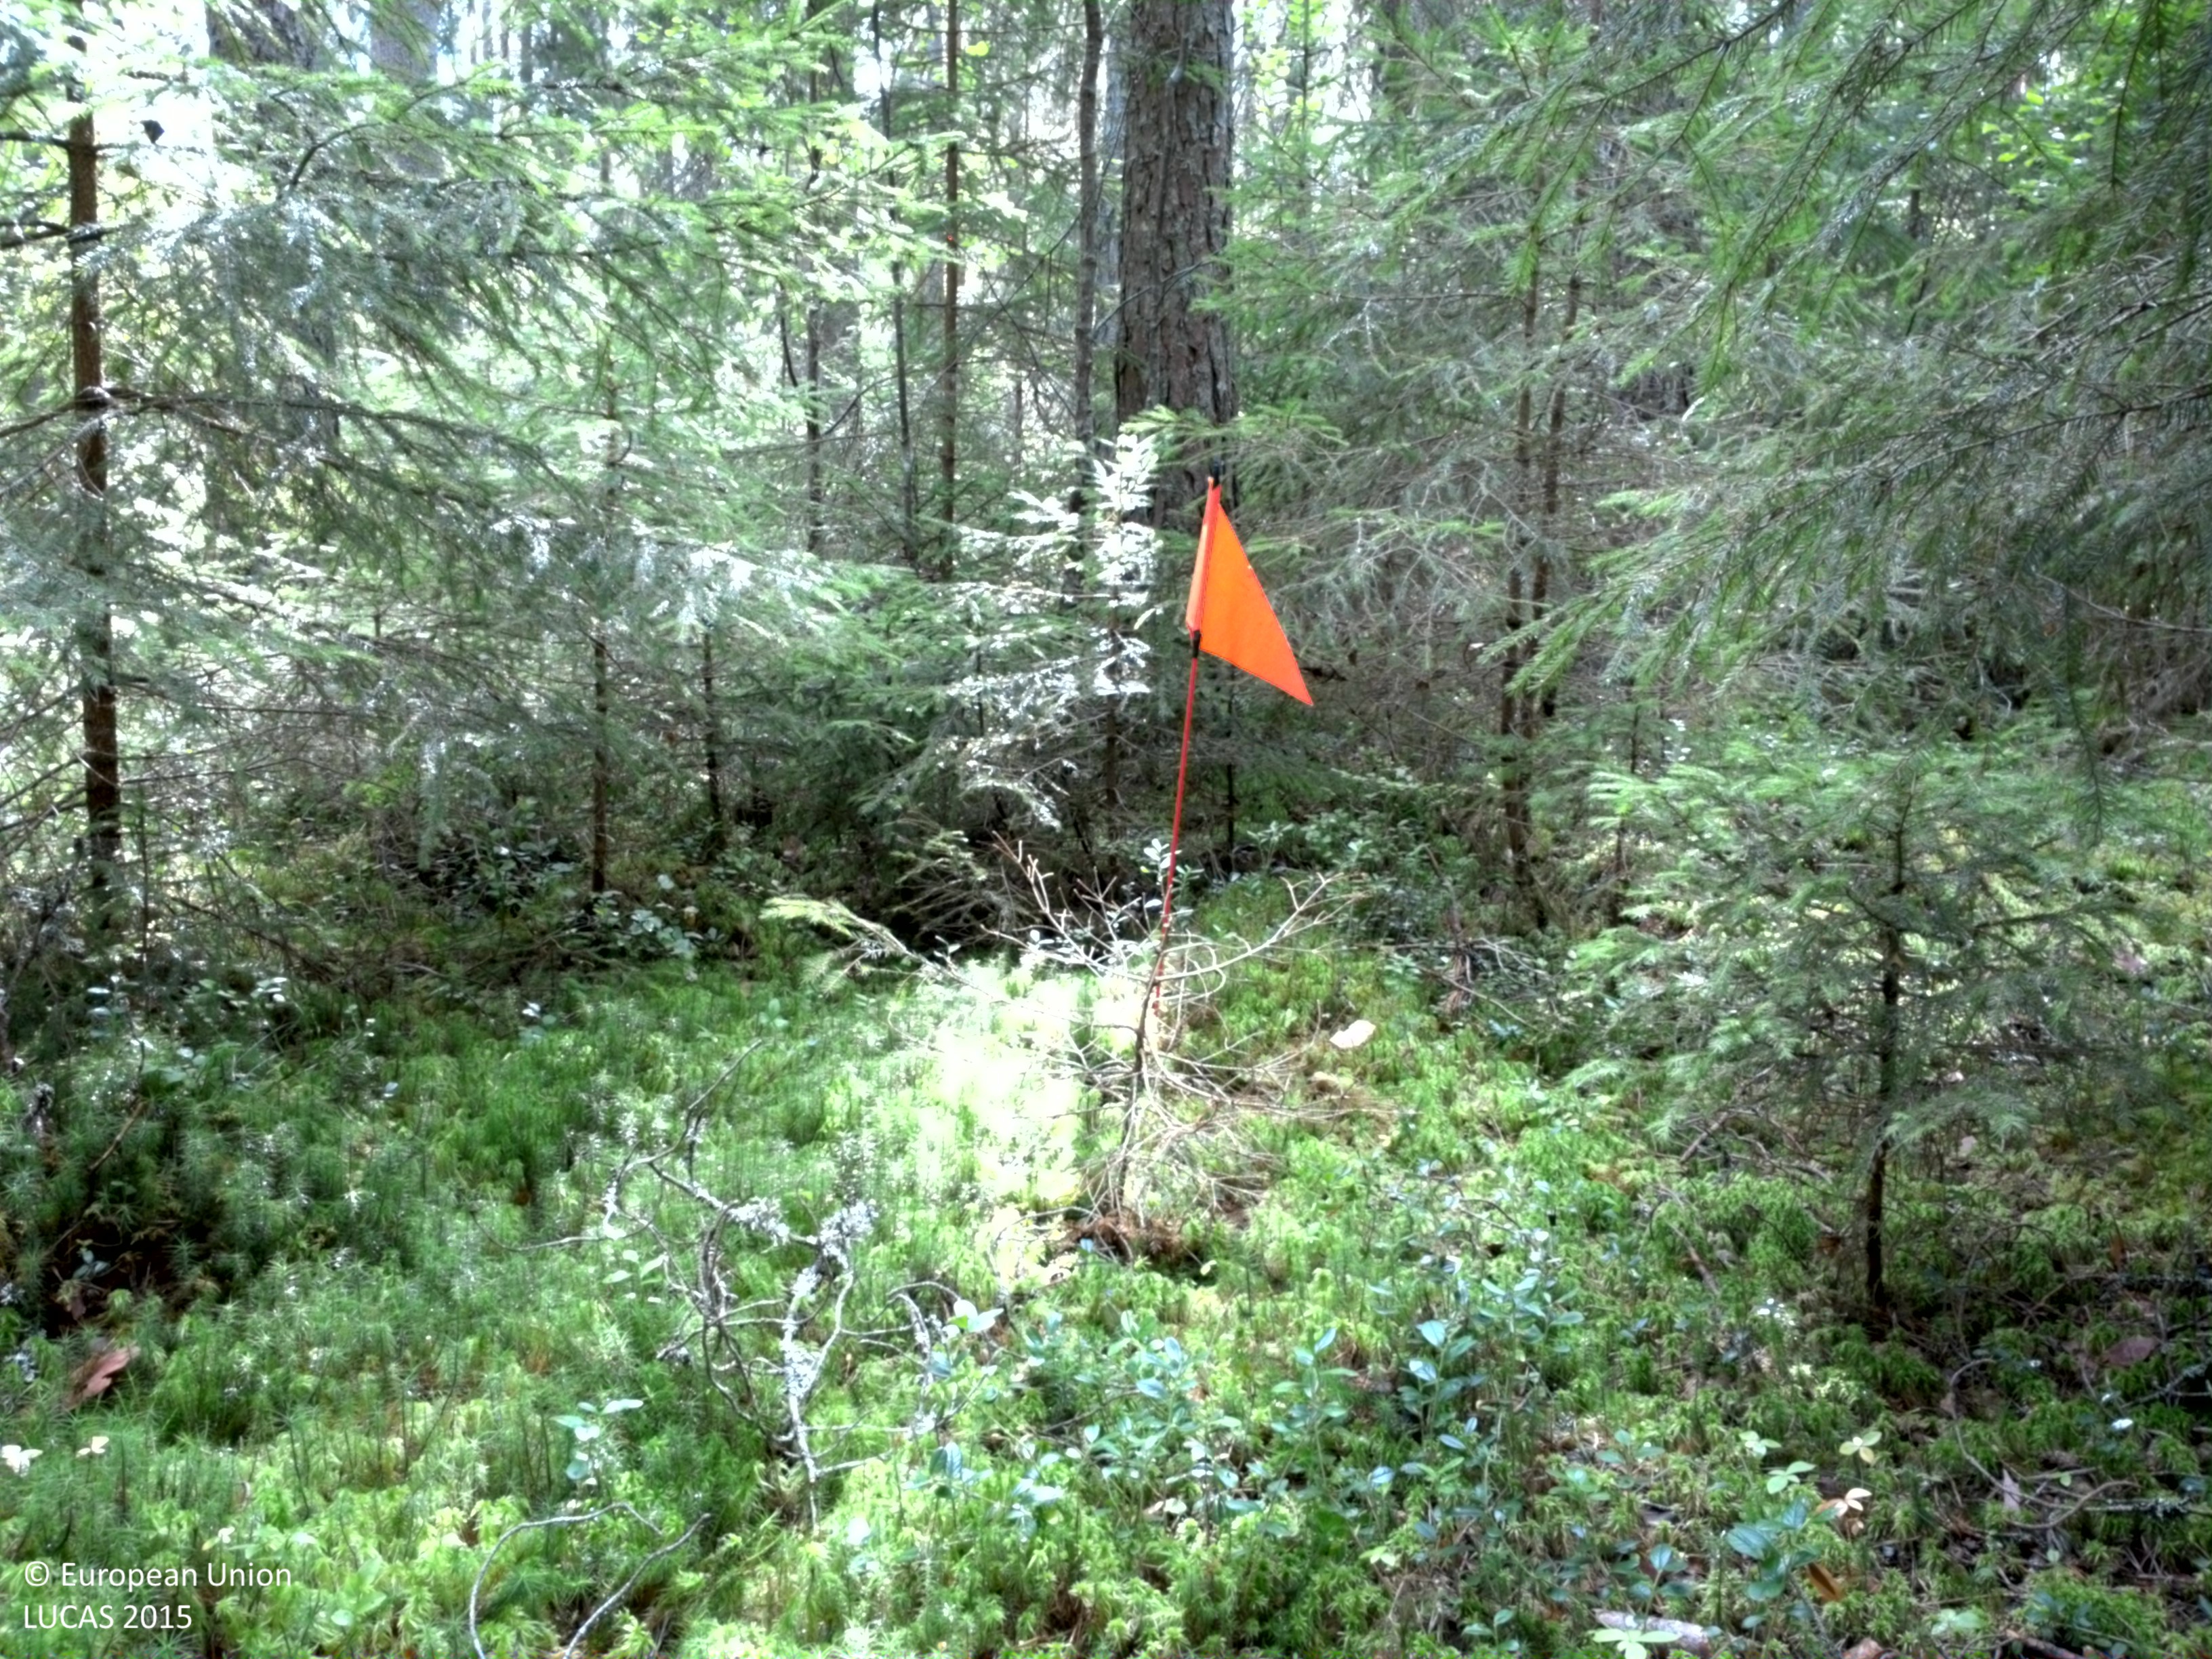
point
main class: Woodland
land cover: Other coniferous woodland
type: boreal forest
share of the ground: > 75 %
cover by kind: coniferous forest trees 75 %, shrubs 10 %, lichens and mosses 10 %, broadleaved forest trees 5 %
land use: Forestry
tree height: > 5 m
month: August
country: SE
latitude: 59.9850
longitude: 16.3168
